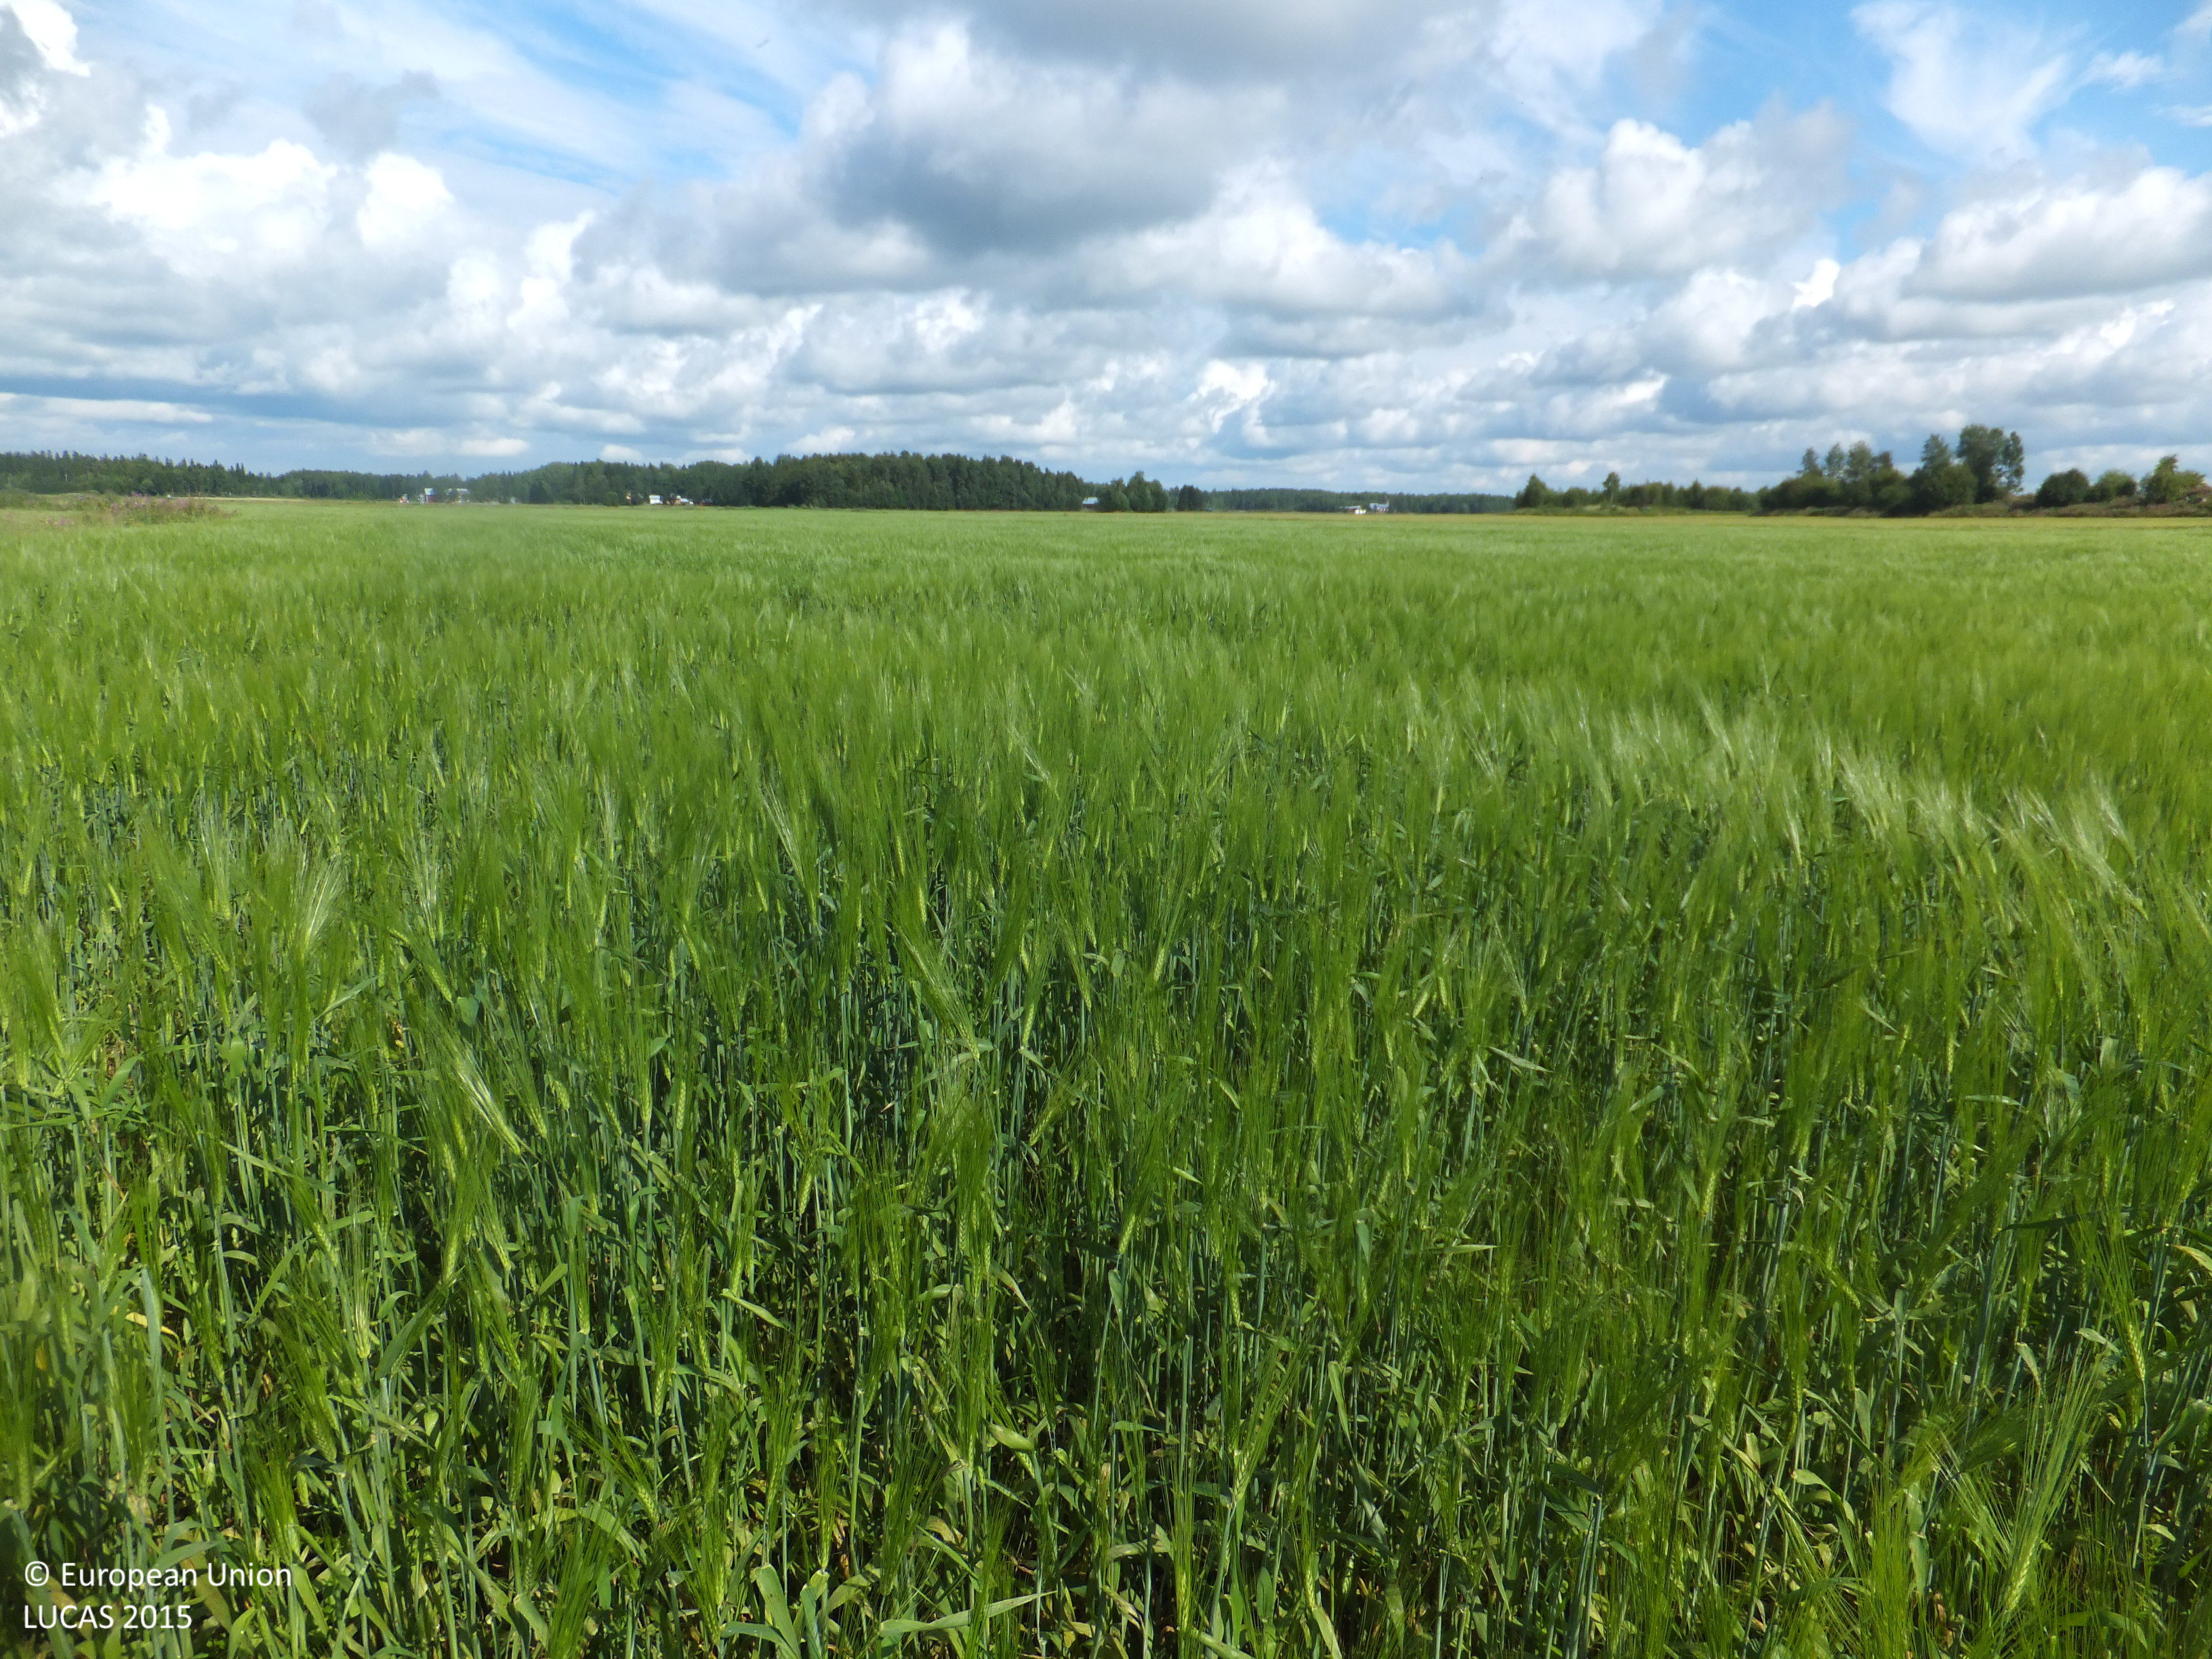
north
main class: Cropland
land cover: Barley
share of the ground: > 75 %
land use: Agriculture (excluding fallow land and kitchen gardens)
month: July
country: FI
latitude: 63.0639
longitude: 22.2163
